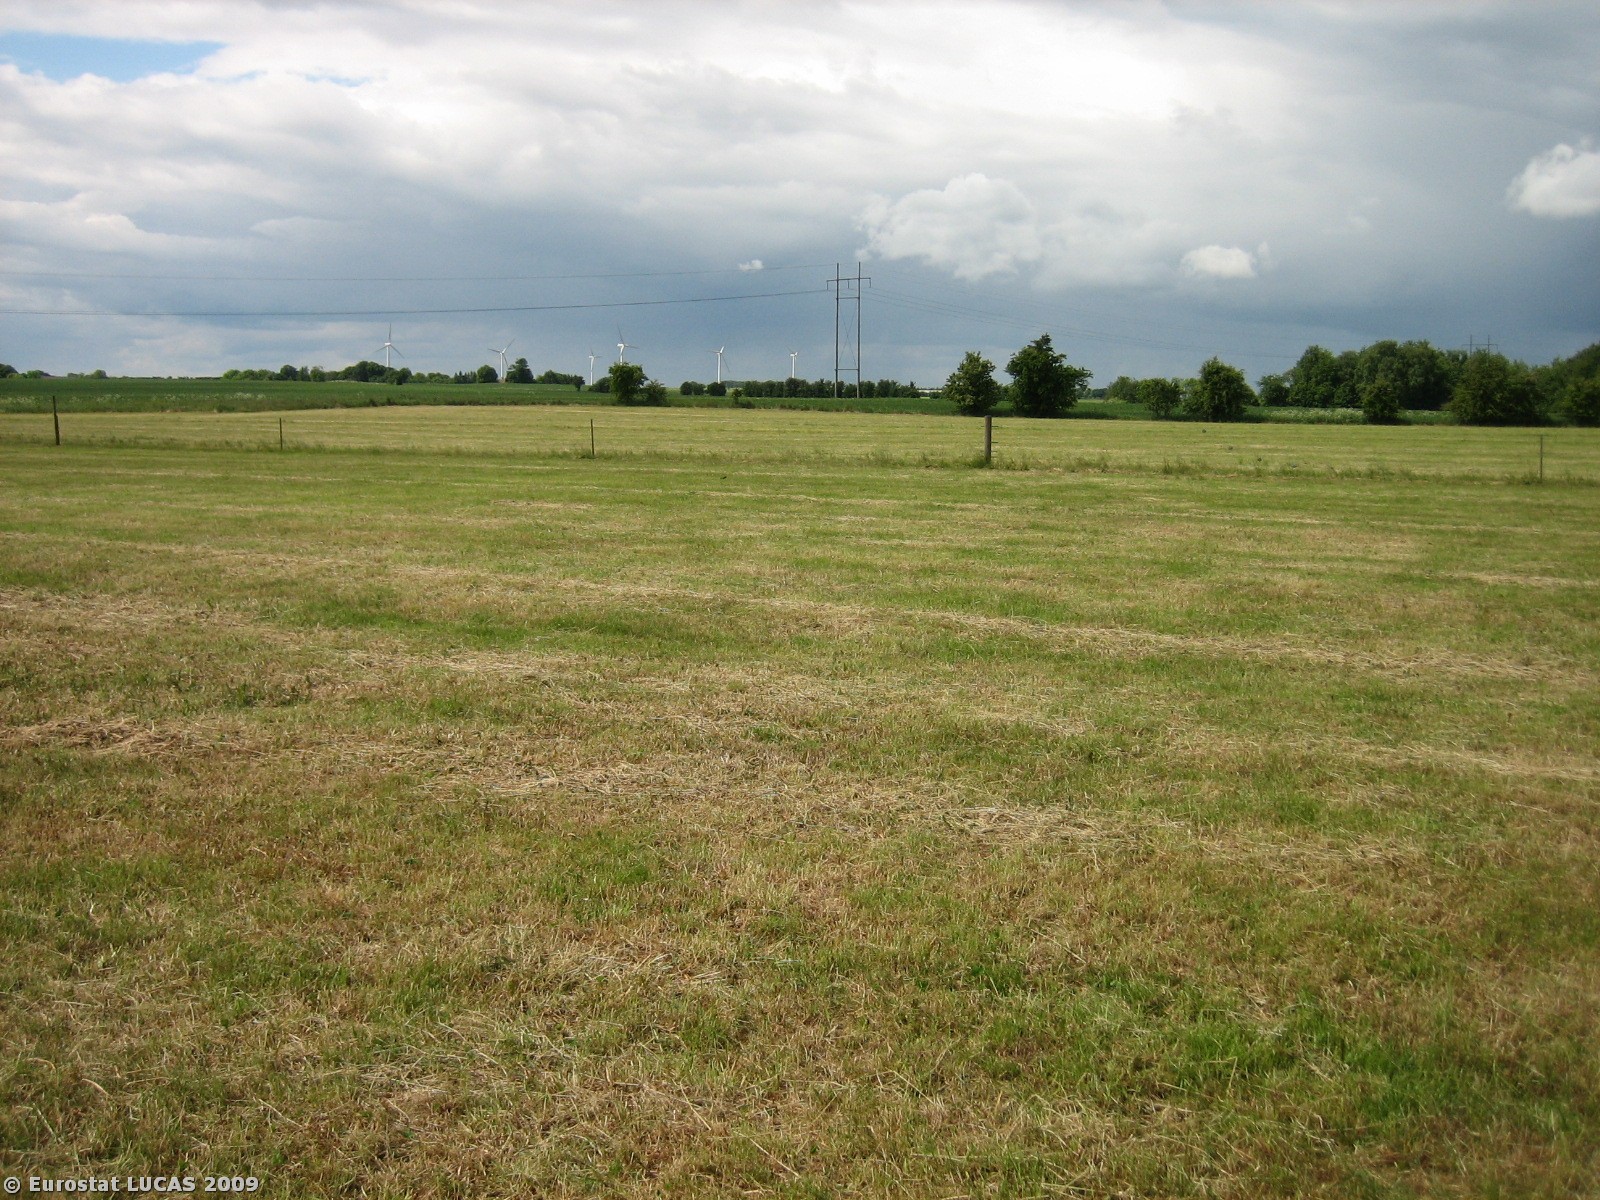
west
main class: Grassland
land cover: Grassland without tree/shrub cover
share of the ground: > 75 %
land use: Agriculture (excluding fallow land and kitchen gardens)
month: June
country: DK
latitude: 56.2593
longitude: 9.7259
